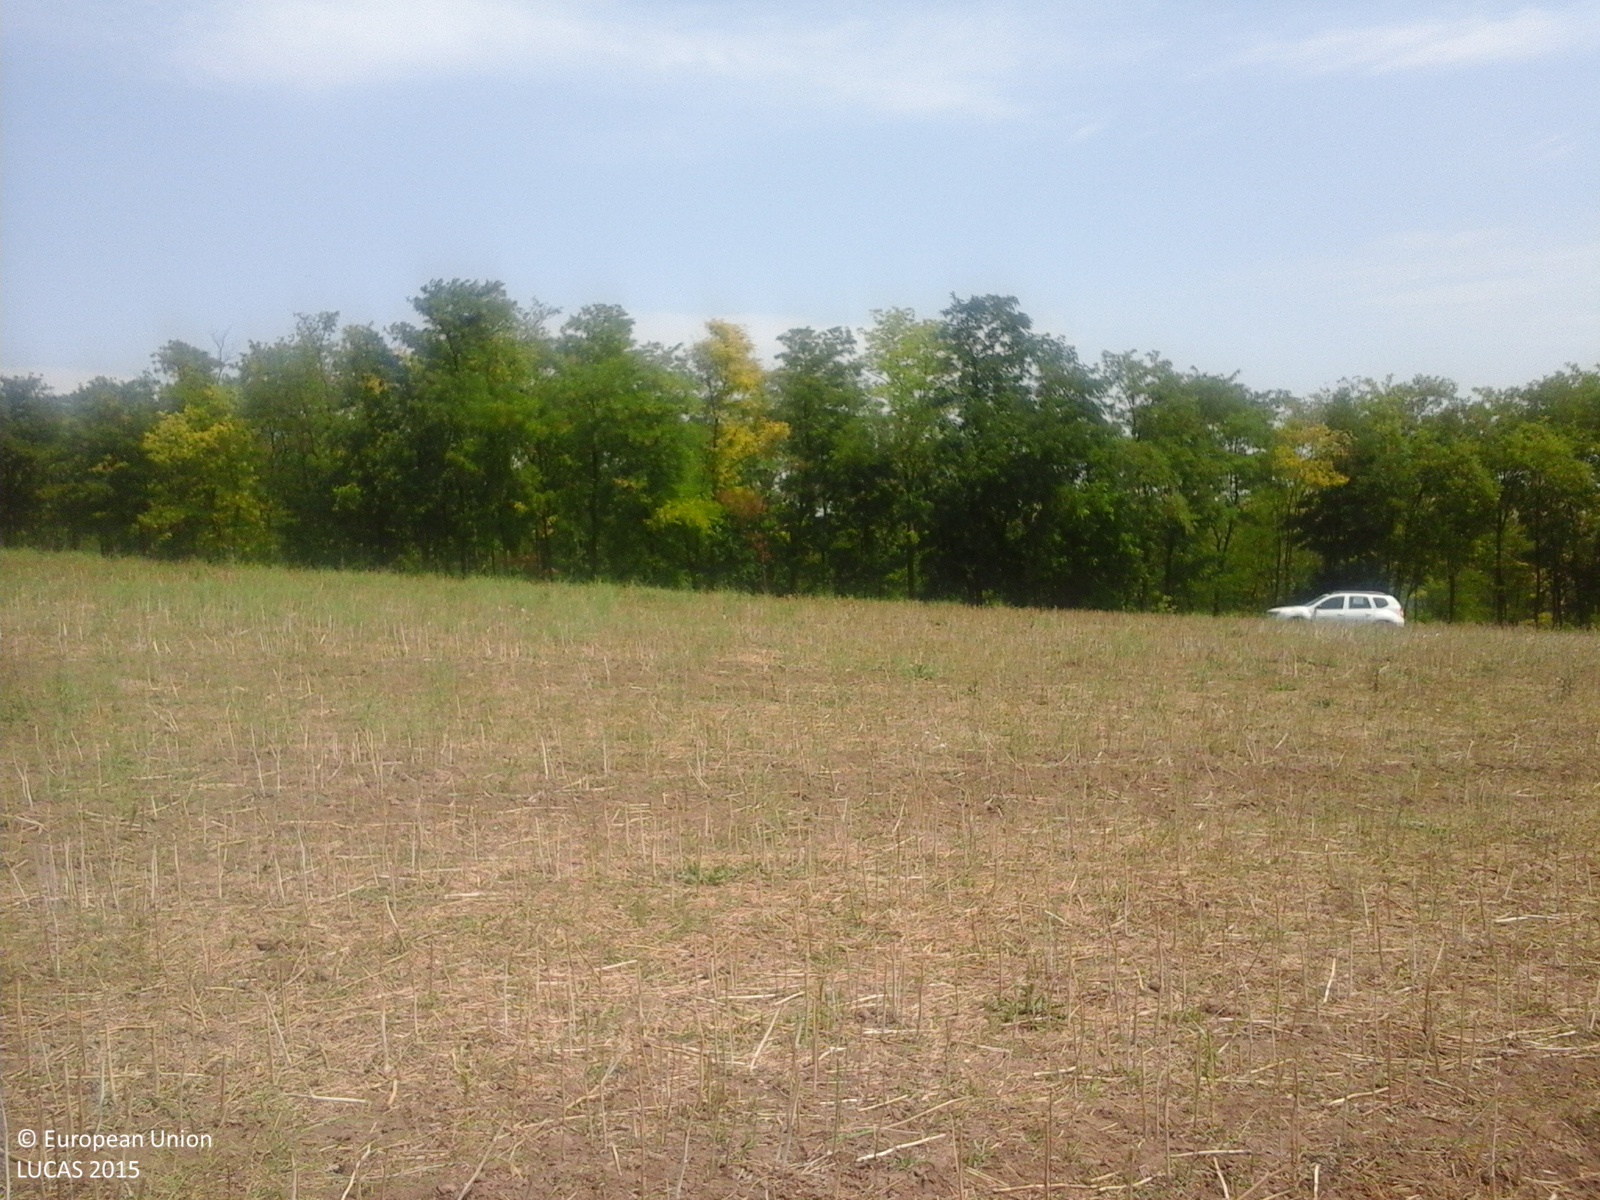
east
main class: Cropland
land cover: Rape and turnip rape
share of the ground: 25 - 50 %
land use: Agriculture (excluding fallow land and kitchen gardens)
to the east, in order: Rape and turnip rape; Tracks; Broadleaved woodland
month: August
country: RO
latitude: 44.0401
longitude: 27.8561
